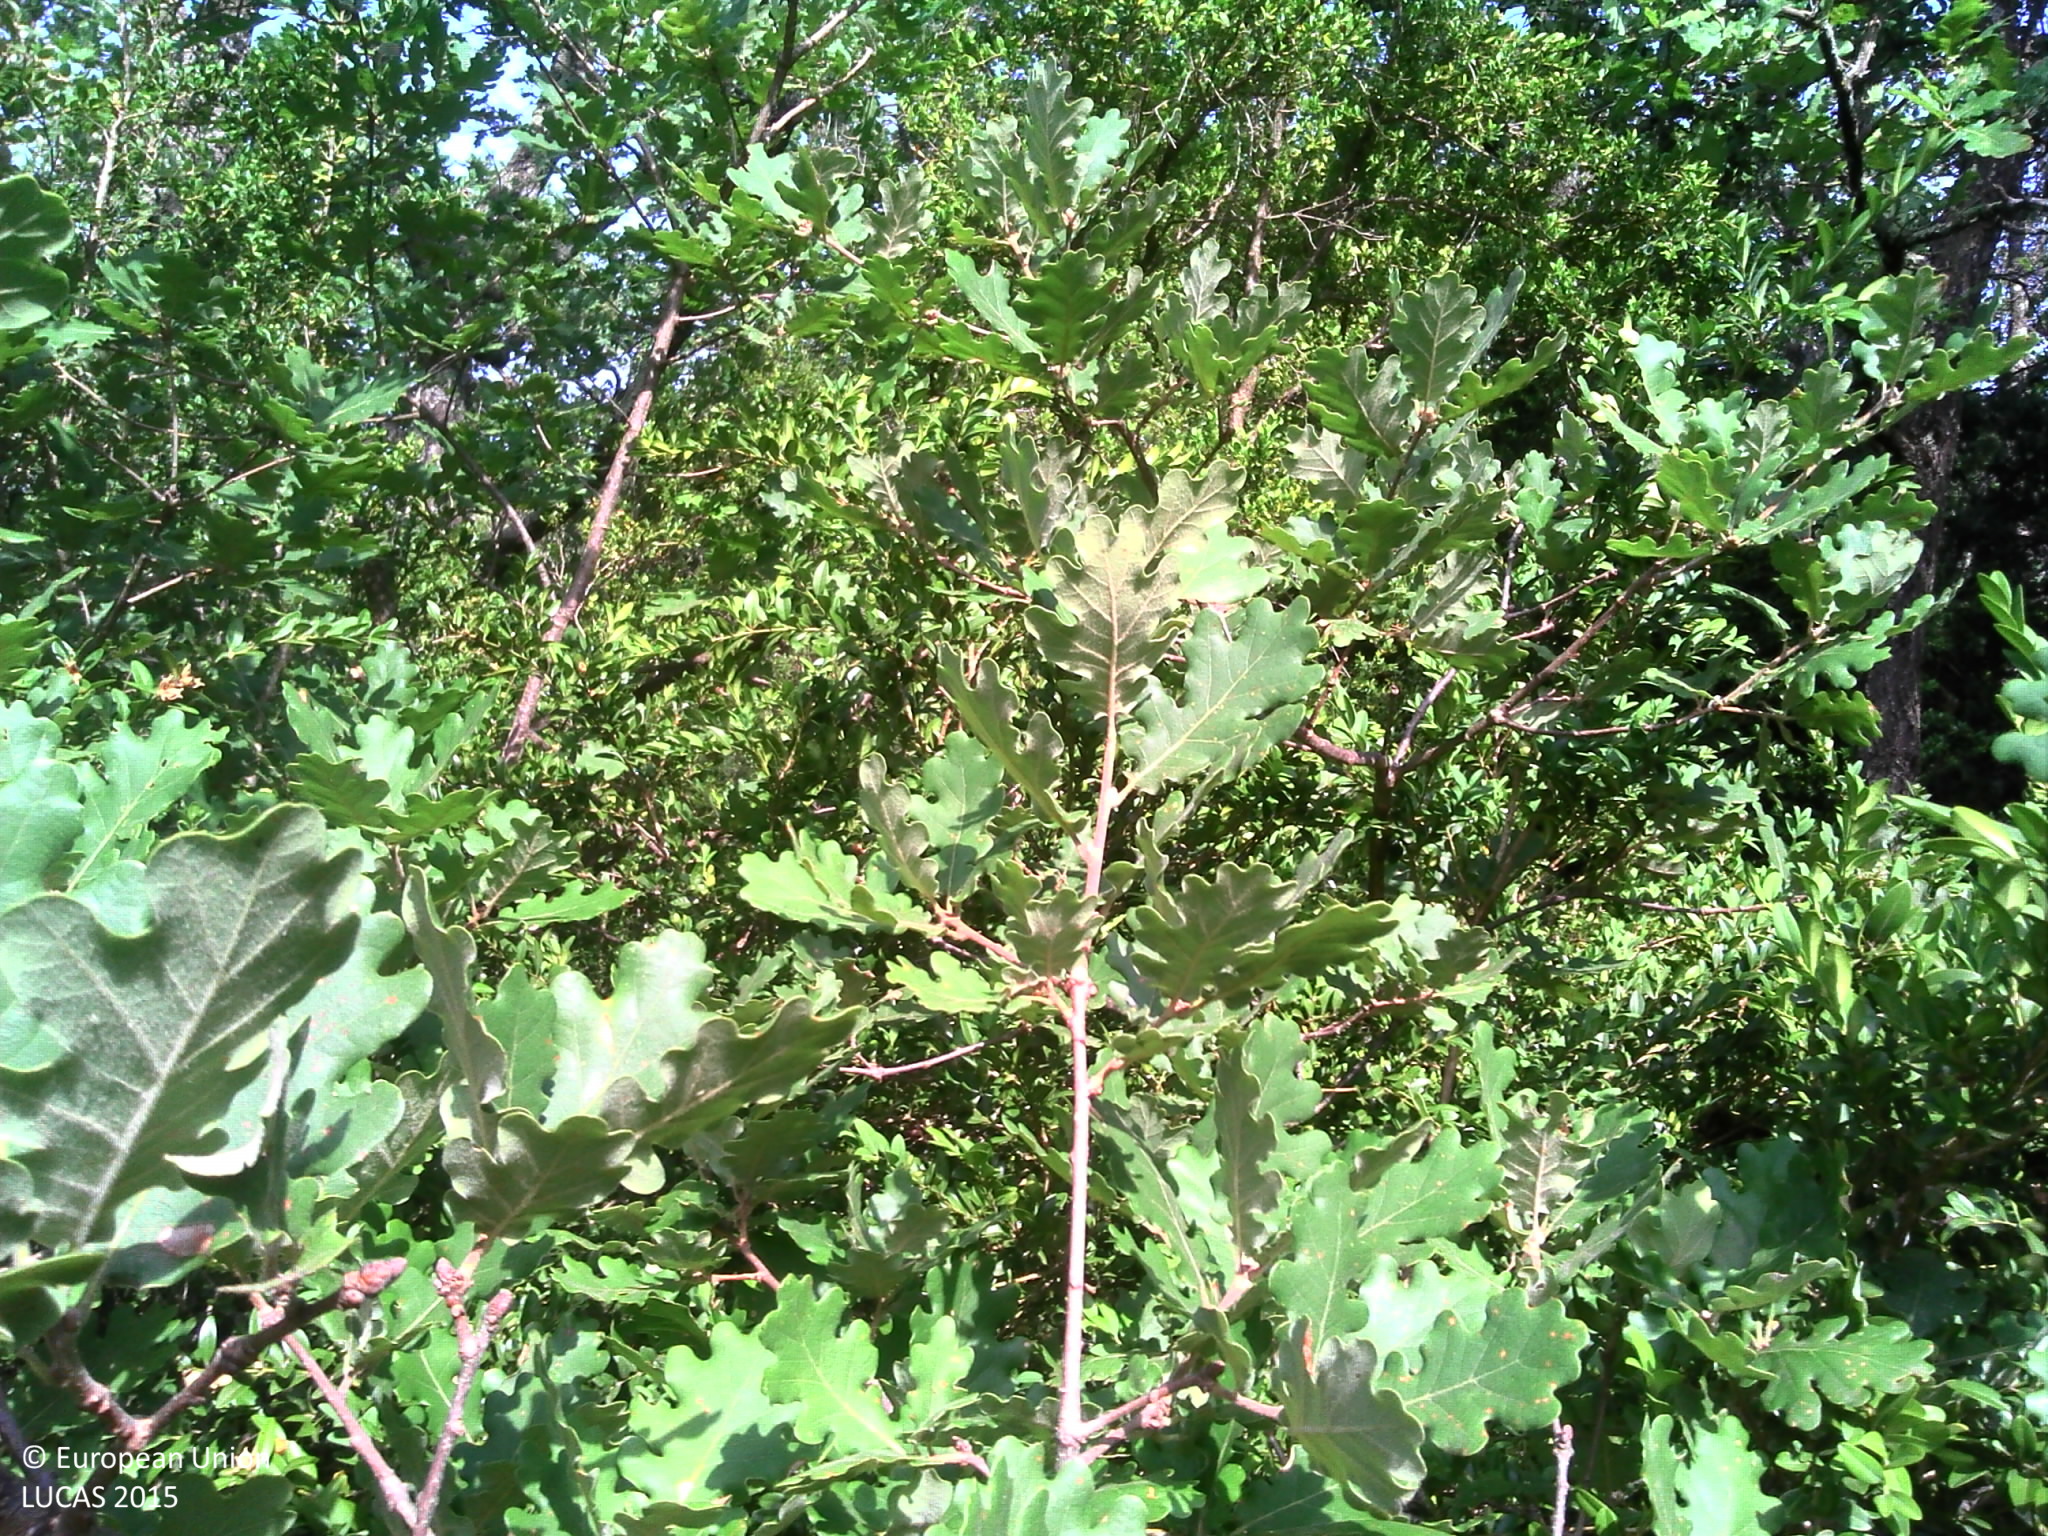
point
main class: Woodland
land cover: Broadleaved woodland
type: thermophilous deciduous forest
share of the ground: > 75 %
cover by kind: broadleaved forest trees 100 %
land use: Forestry
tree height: < 5 m
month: July
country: FR
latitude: 44.4355
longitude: 4.7682
